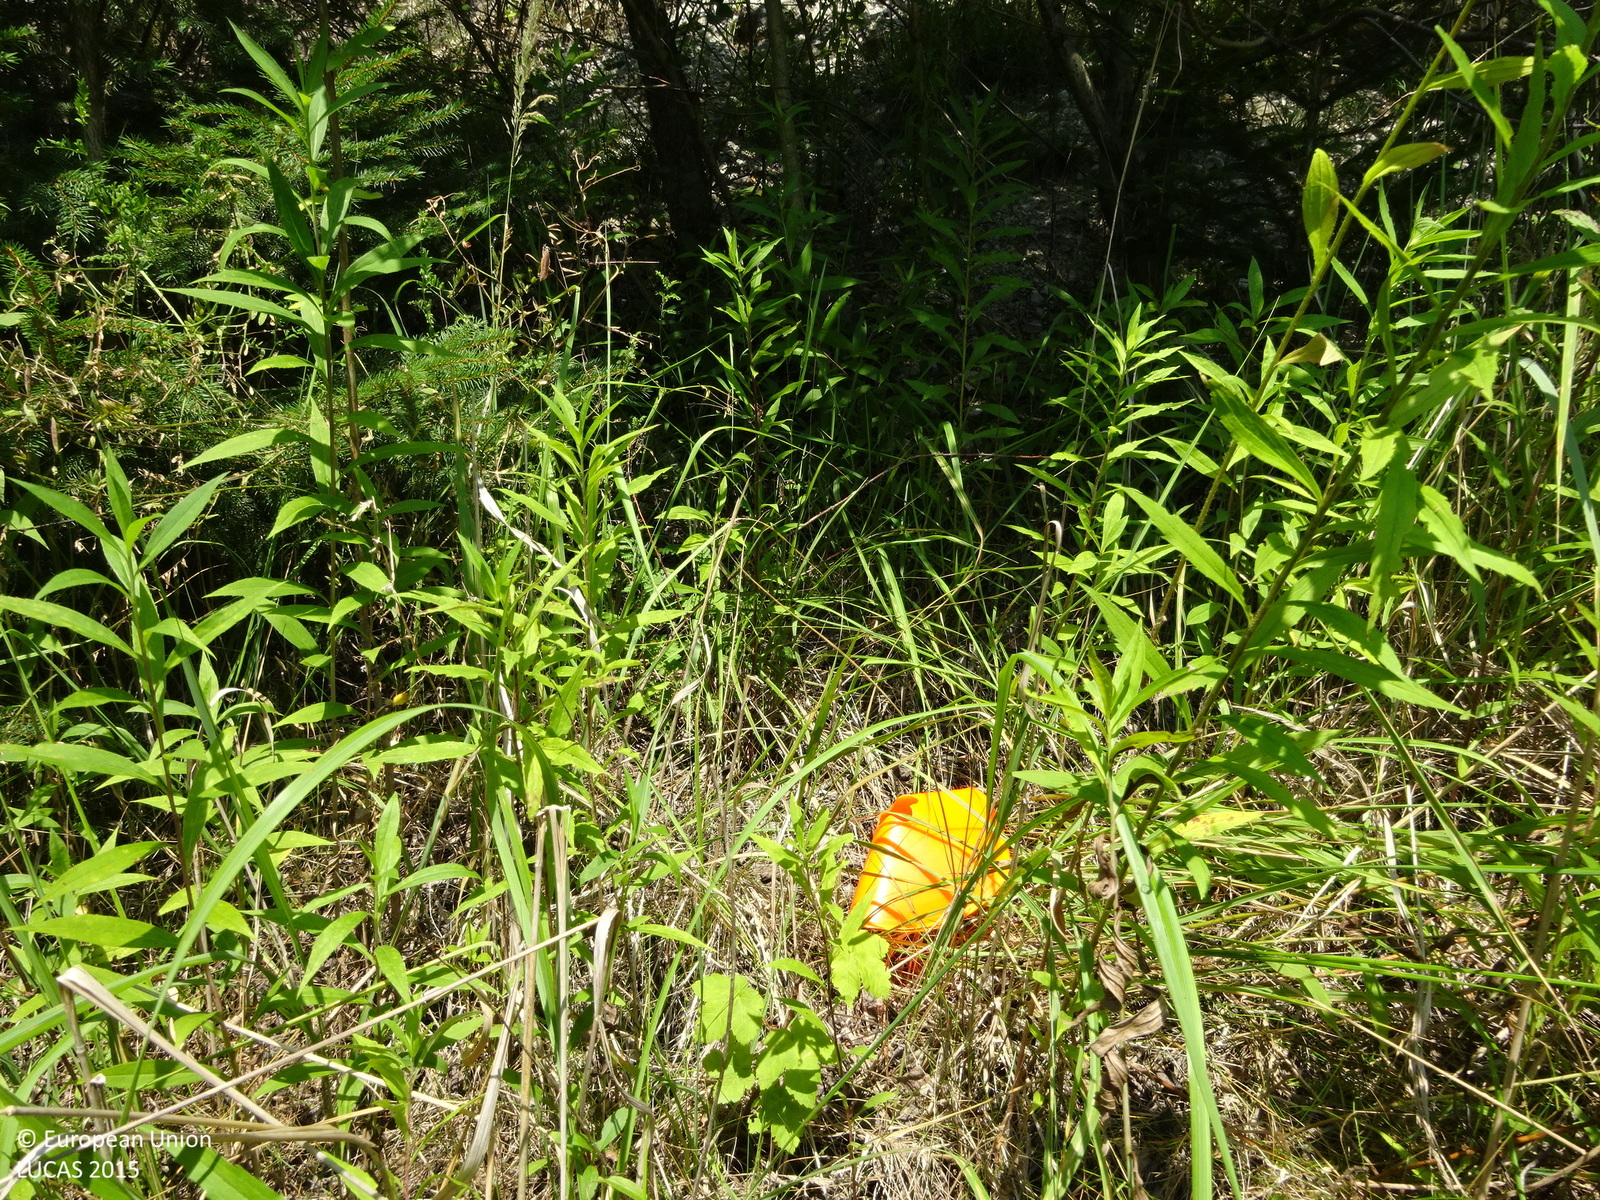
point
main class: Shrubland
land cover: Shrubland with sparse tree cover
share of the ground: 50 - 75 %
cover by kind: shrubs 75 %, herbaceous plants 20 %, coniferous forest trees 5 %
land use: Abandoned areas
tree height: > 5 m
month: July
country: AT
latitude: 47.1741
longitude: 15.3435
